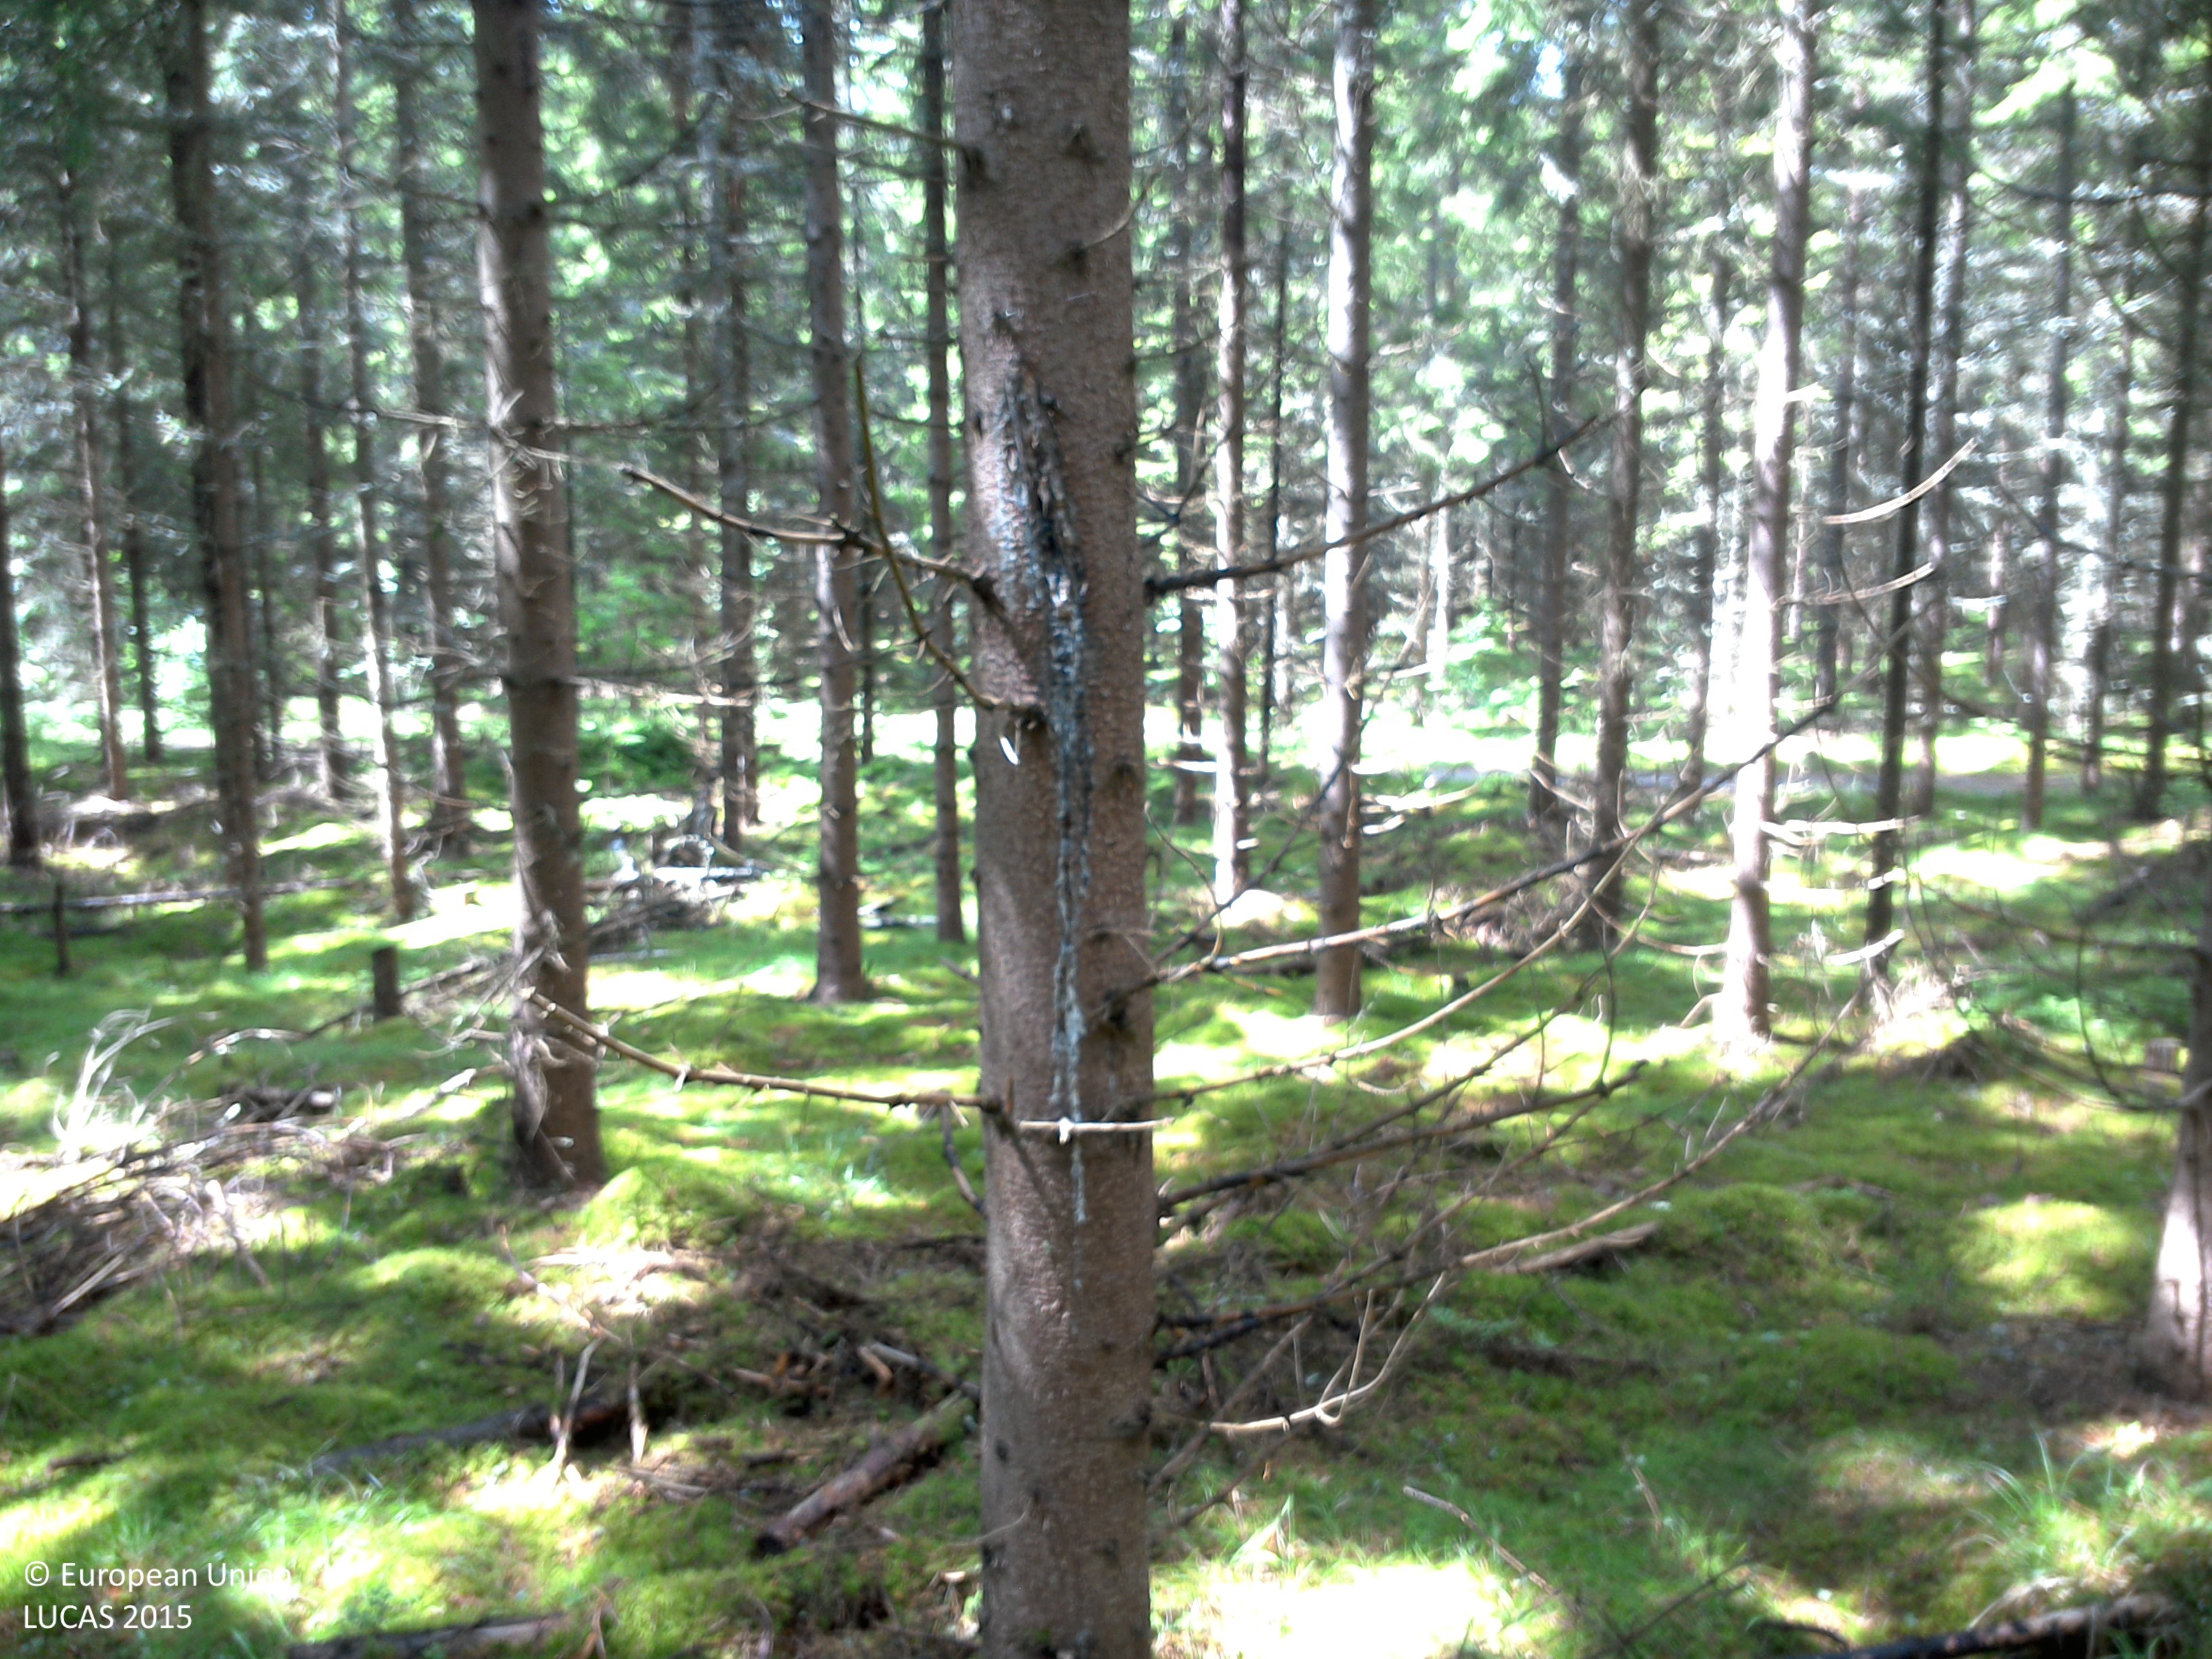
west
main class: Woodland
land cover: Spruce dominated coniferous woodland
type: boreal forest
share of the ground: > 75 %
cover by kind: coniferous forest trees 75 %, lichens and mosses 25 %
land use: Forestry
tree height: > 5 m
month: July
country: SE
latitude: 58.5965
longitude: 14.9661
